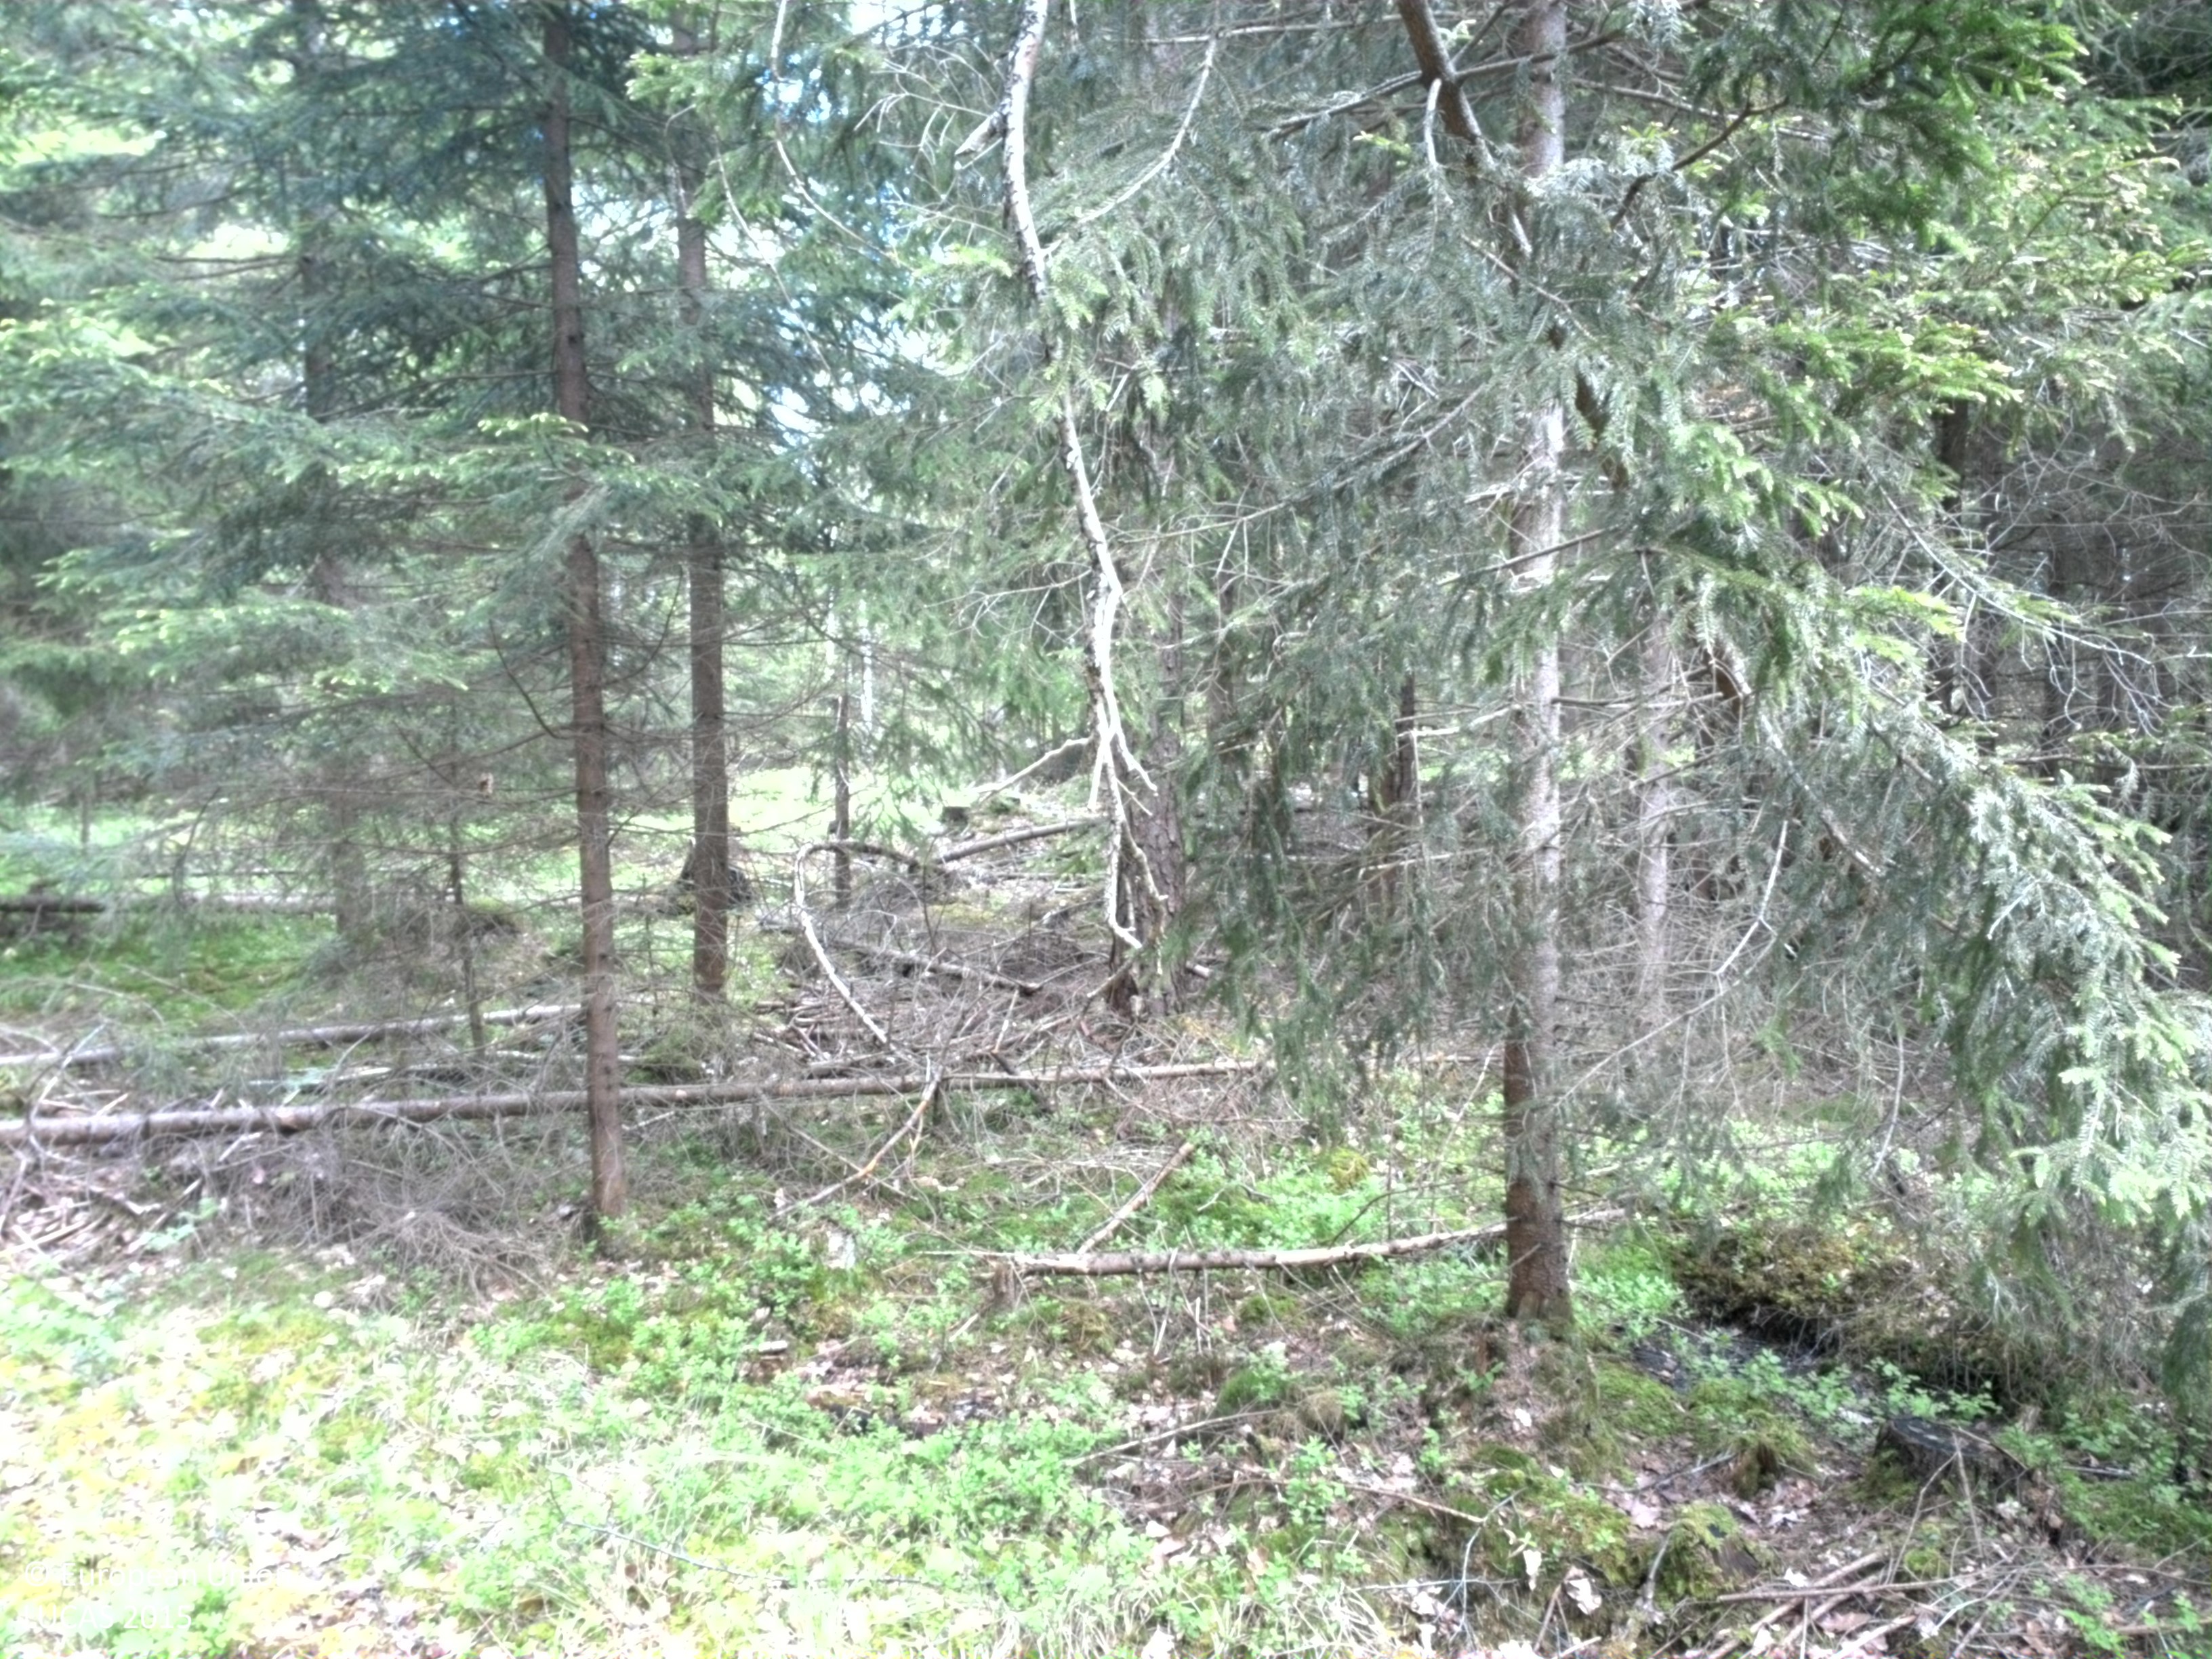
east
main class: Woodland
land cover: Spruce dominated mixed woodland
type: boreal forest
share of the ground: > 75 %
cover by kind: coniferous forest trees 60 %, broadleaved forest trees 25 %, herbaceous plants 15 %
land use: Forestry
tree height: > 5 m
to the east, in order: Spruce dominated mixed woodland; Pine dominated mixed woodland; Rock outcrops; Shrubland with sparse tree cover; Electric lines; Shrubland with sparse tree cover; Pine dominated mixed woodland; Spruce dominated mixed woodland
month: May
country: SE
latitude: 58.6325
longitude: 12.2516
